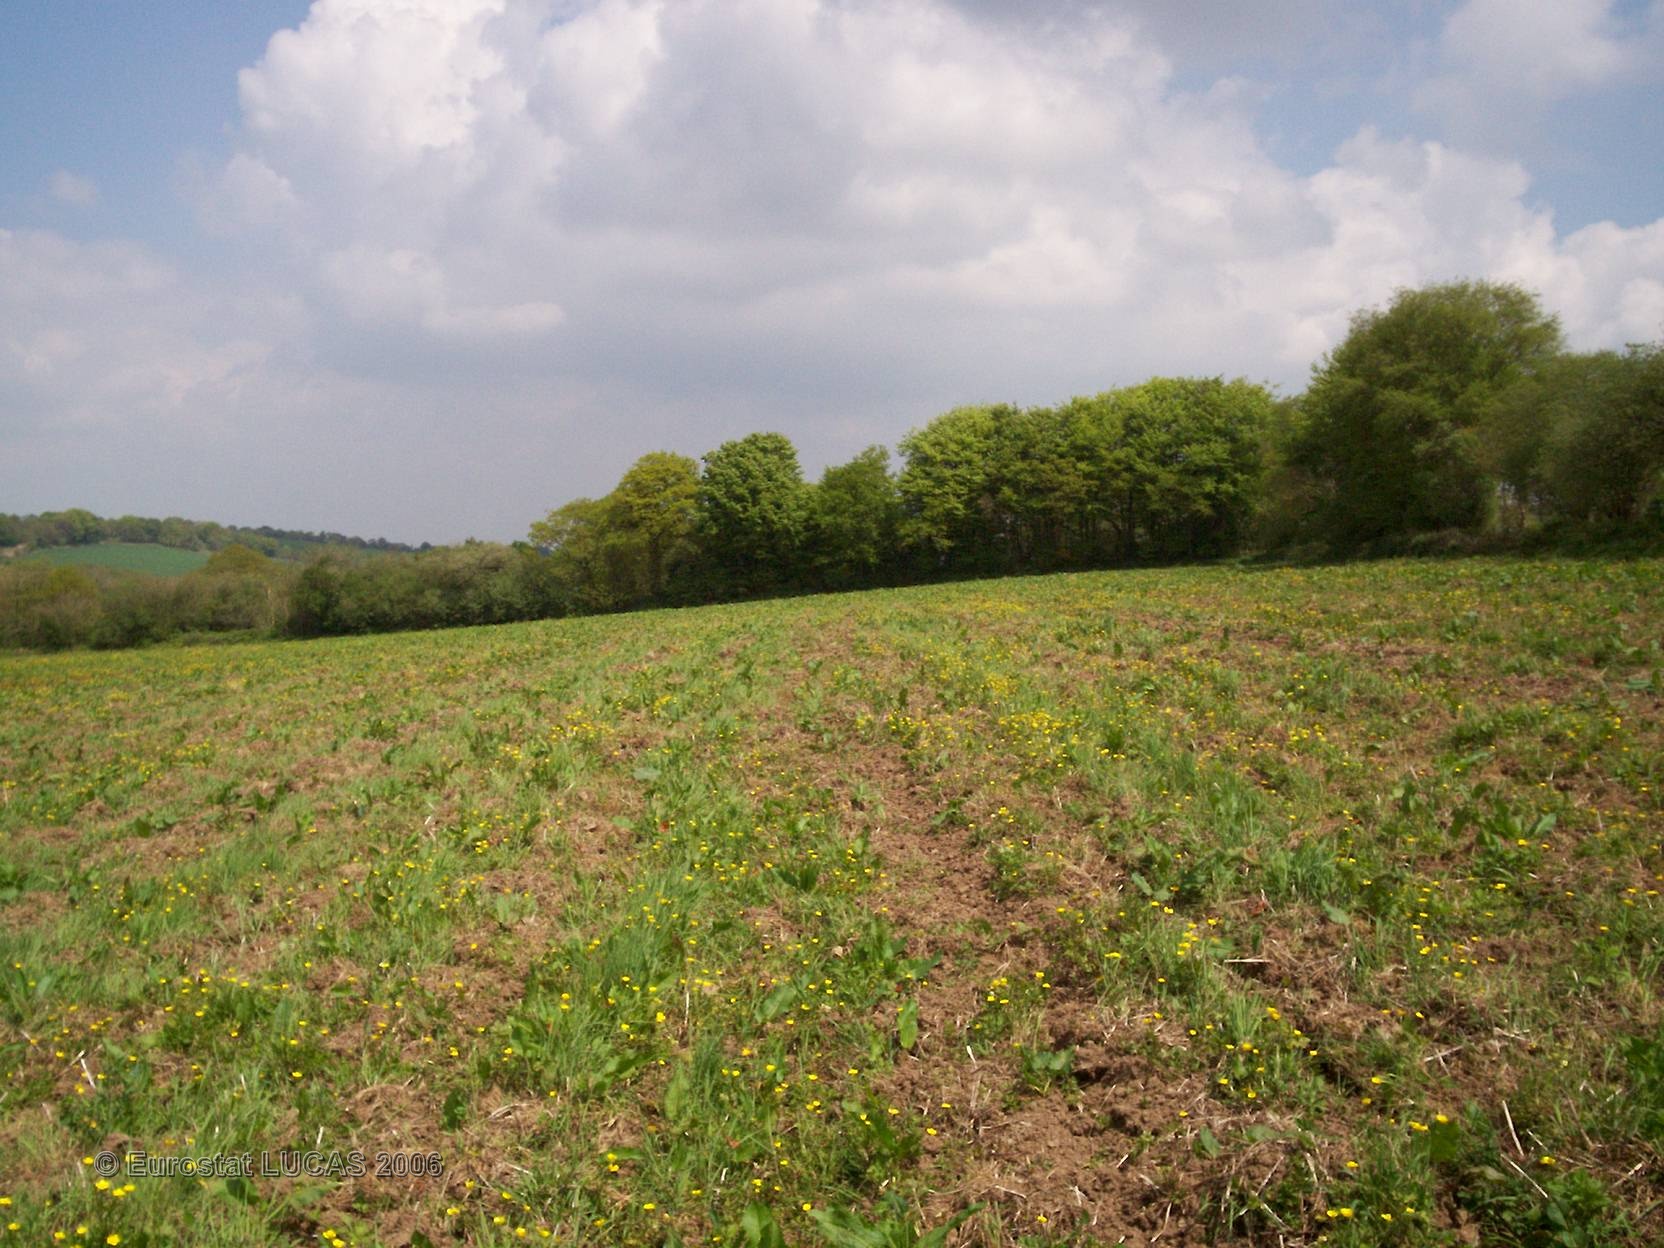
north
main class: Grassland
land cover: Grassland without tree/shrub cover
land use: Fallow land
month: May
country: FR
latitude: 48.1358
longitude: -3.9401
